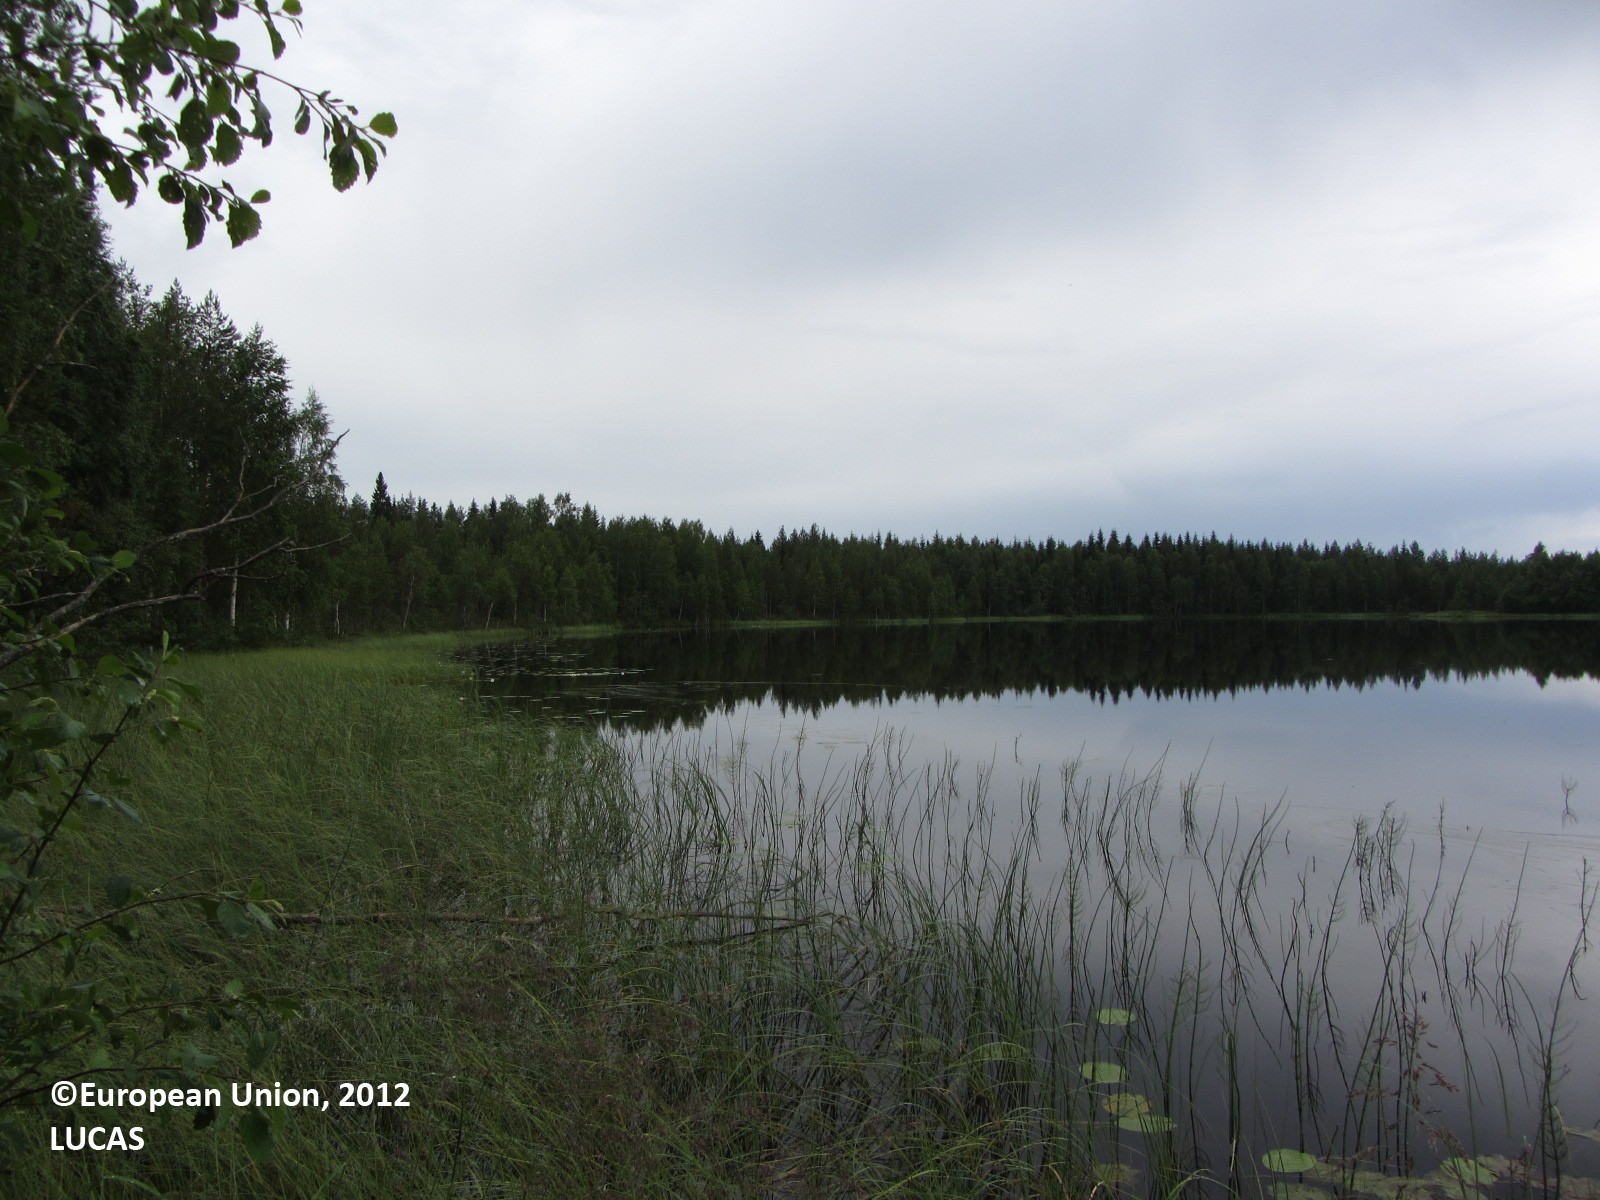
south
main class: Woodland
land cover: Pine dominated coniferous woodland
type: boreal forest
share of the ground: 50 - 75 %
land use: Forestry
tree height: > 5 m
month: July
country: FI
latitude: 63.5893
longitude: 25.3511
